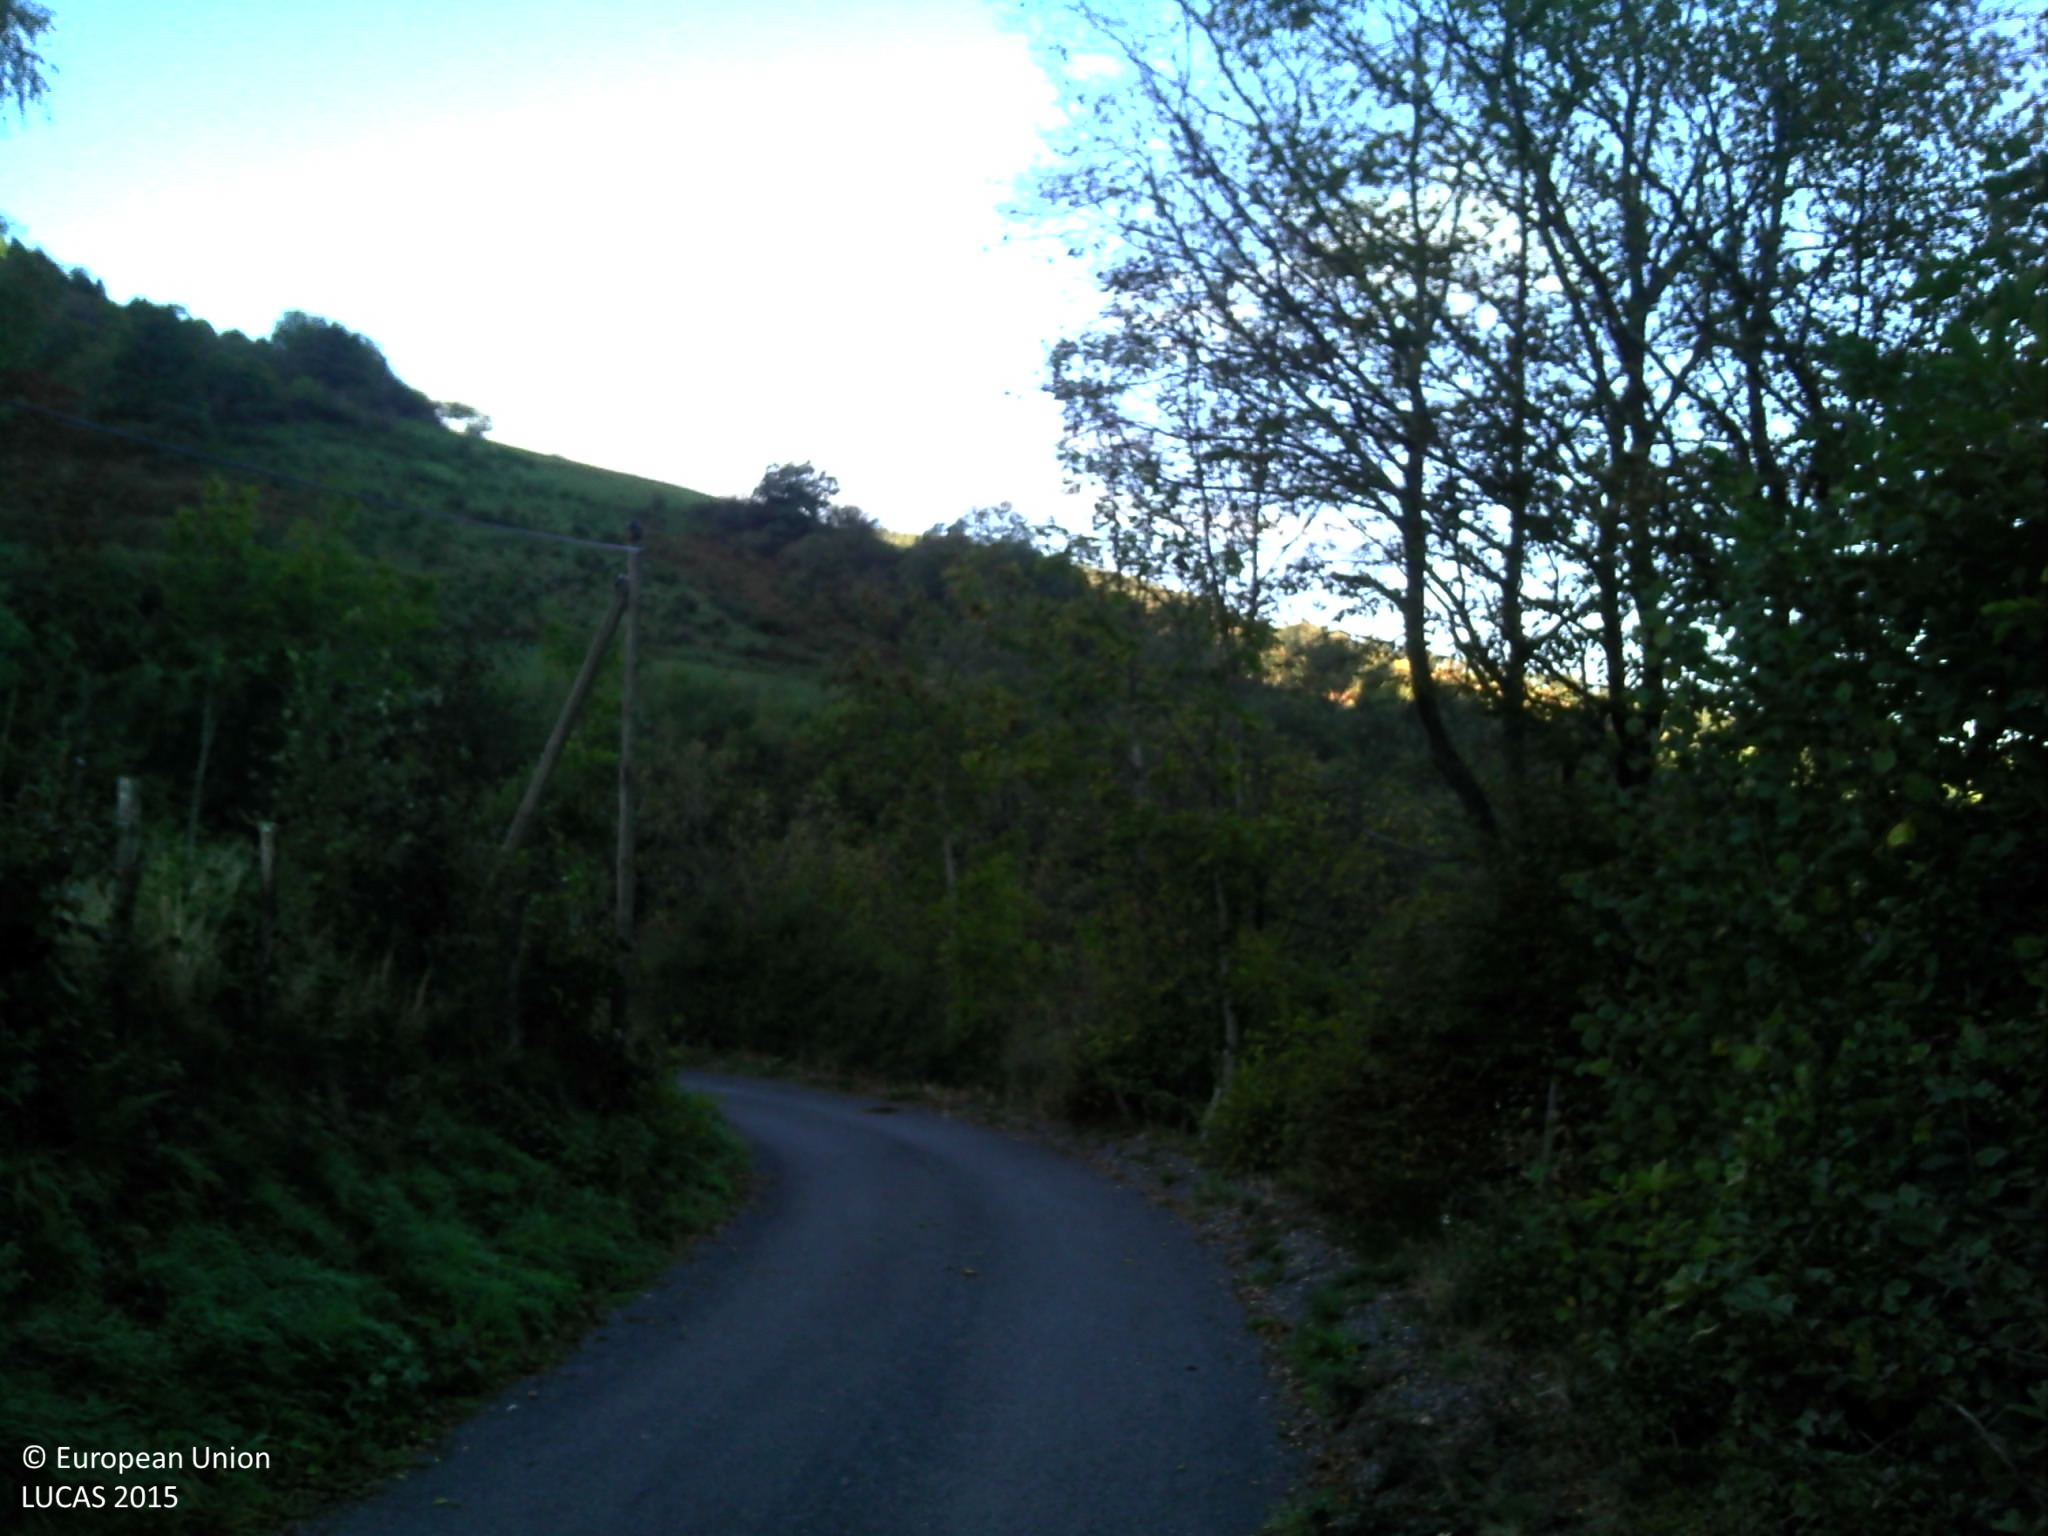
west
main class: Woodland
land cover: Broadleaved woodland
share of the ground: > 75 %
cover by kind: broadleaved forest trees 95 %, herbaceous plants 5 %
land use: Semi-natural and natural areas not in use
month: September
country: FR
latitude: 45.3997
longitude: 4.5492
